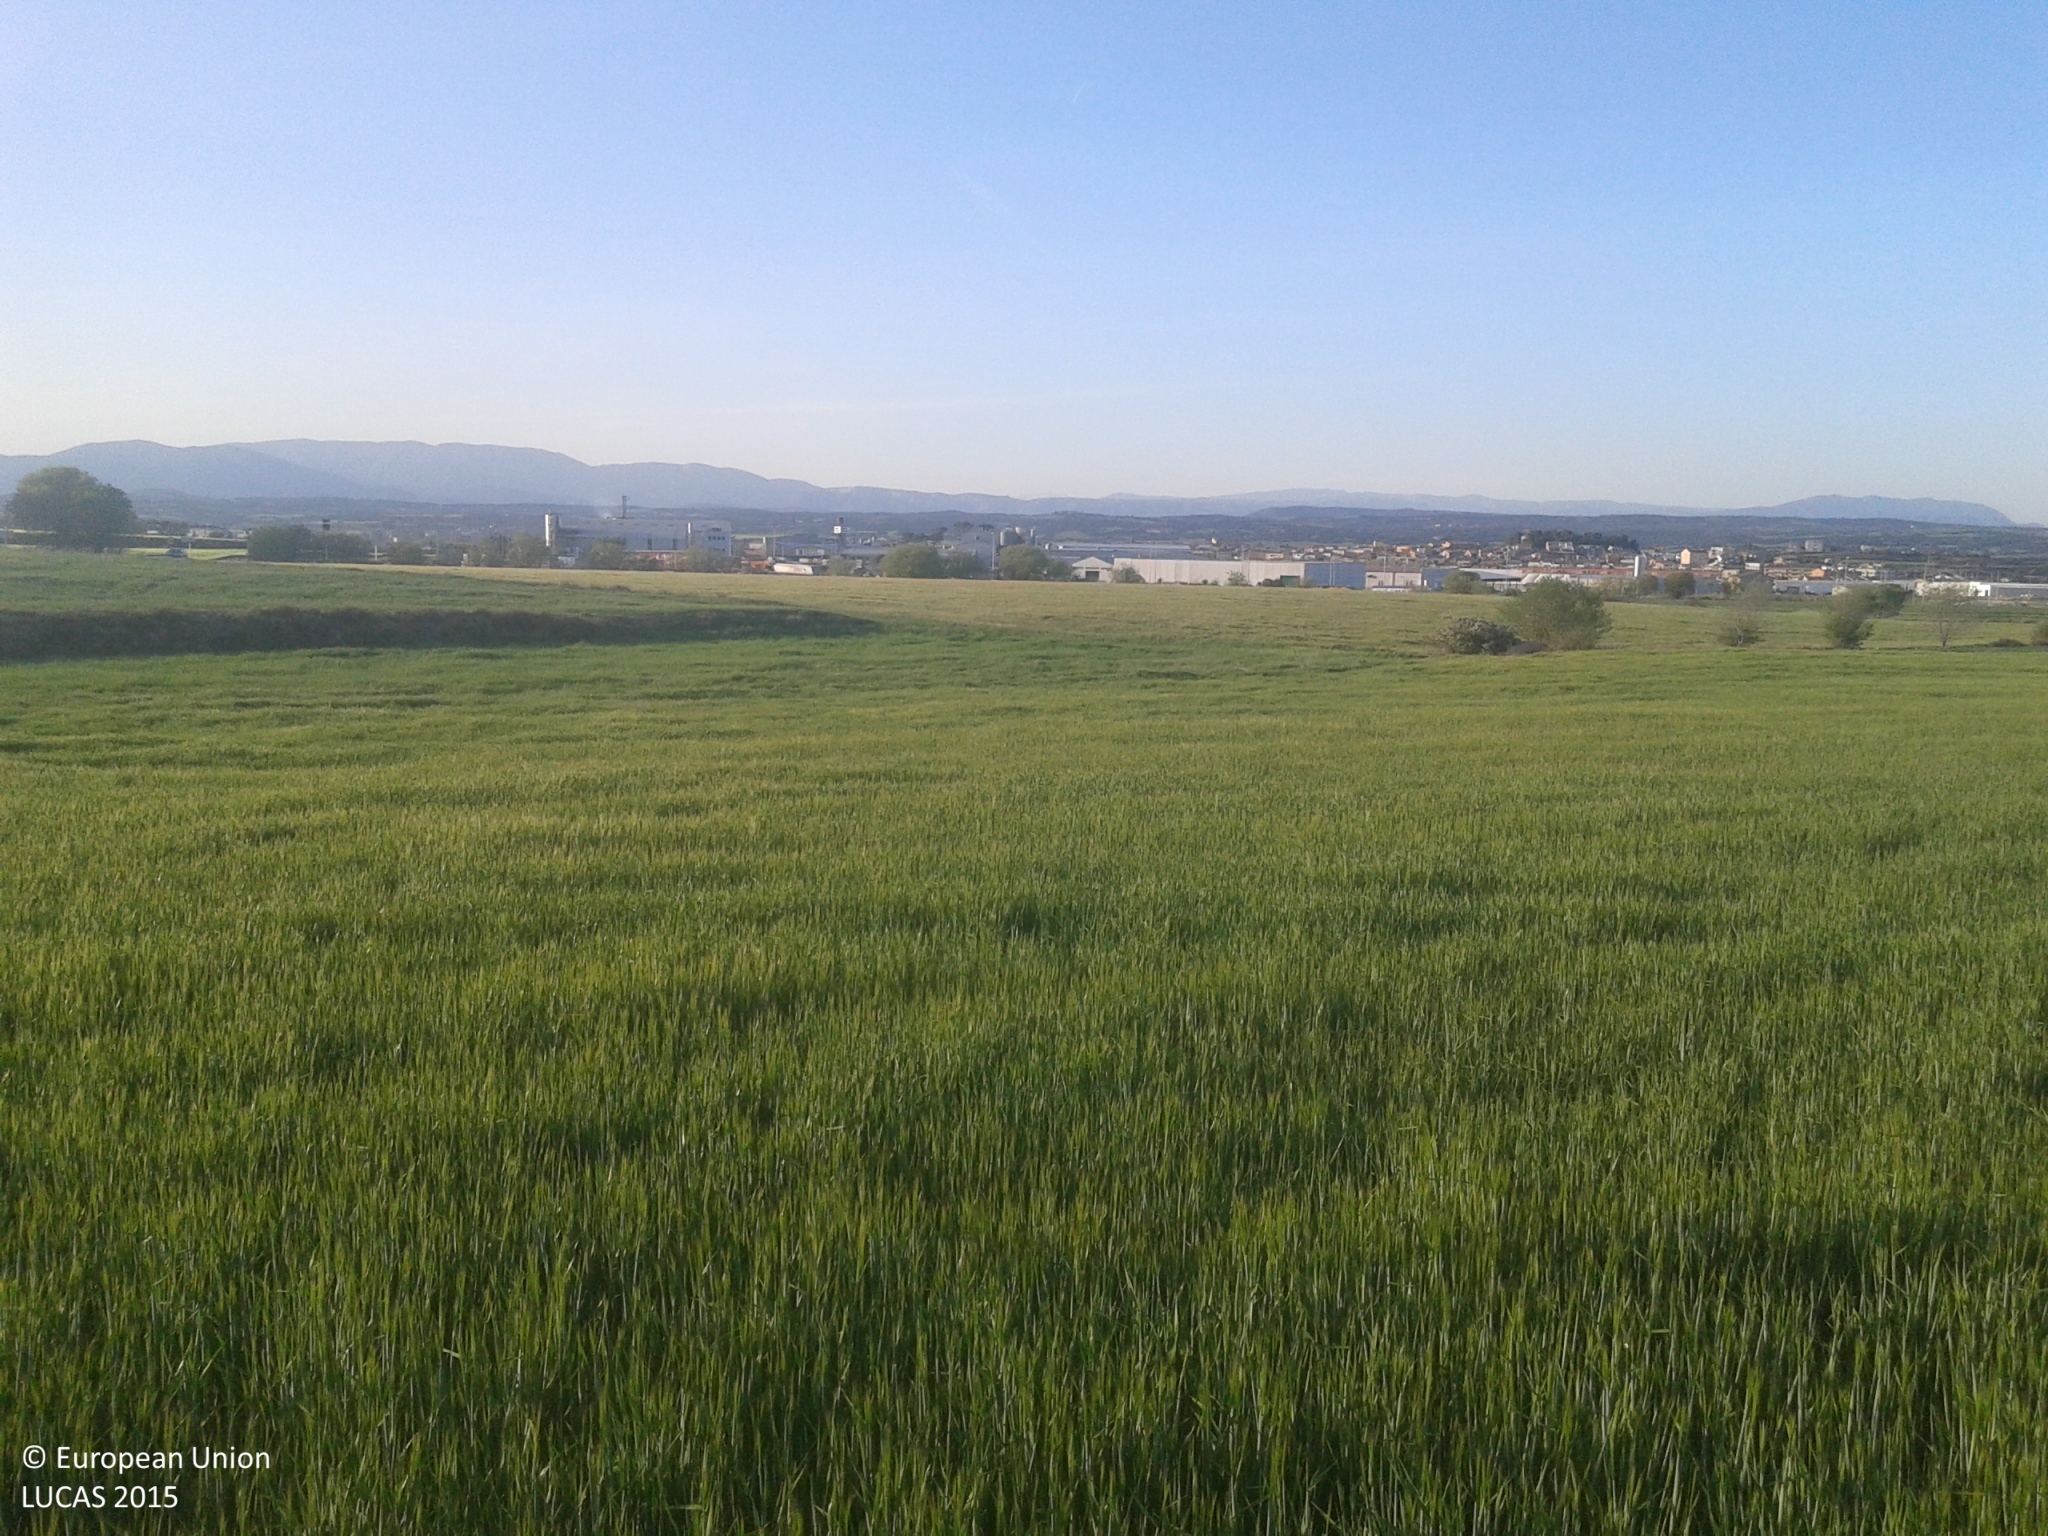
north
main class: Cropland
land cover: Rye
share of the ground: > 75 %
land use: Agriculture (excluding fallow land and kitchen gardens)
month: April
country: ES
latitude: 41.7710
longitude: 1.0985
